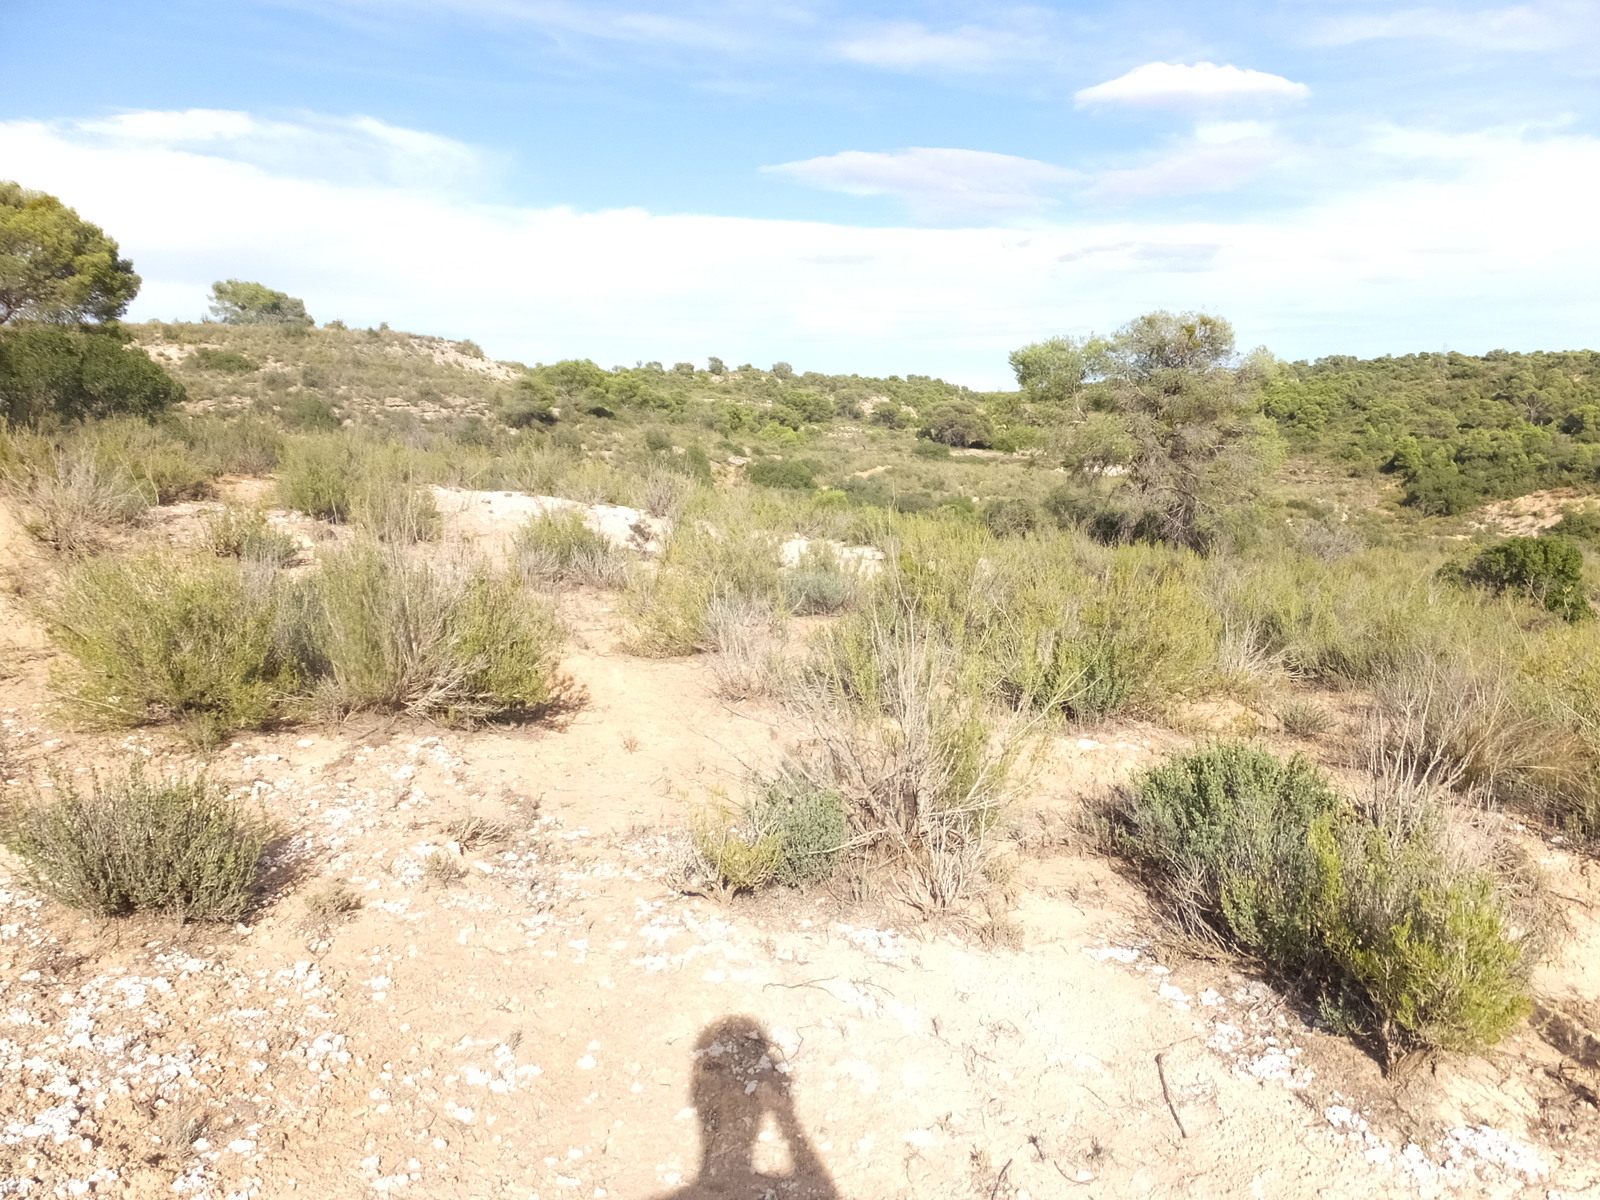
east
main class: Shrubland
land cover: Shrubland with sparse tree cover
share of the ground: > 75 %
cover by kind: shrubs 75 %, herbaceous plants 15 %, coniferous forest trees 5 %, unconsolidated bare surface 5 %
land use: Semi-natural and natural areas not in use
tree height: < 5 m
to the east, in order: Shrubland with sparse tree cover; Tracks; Shrubland with sparse tree cover; Tracks; Shrubland with sparse tree cover; Tracks; Shrubland with sparse tree cover; Tracks; Shrubland with sparse tree cover; Nuts trees
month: August
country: ES
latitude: 41.2781
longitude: 0.1146
